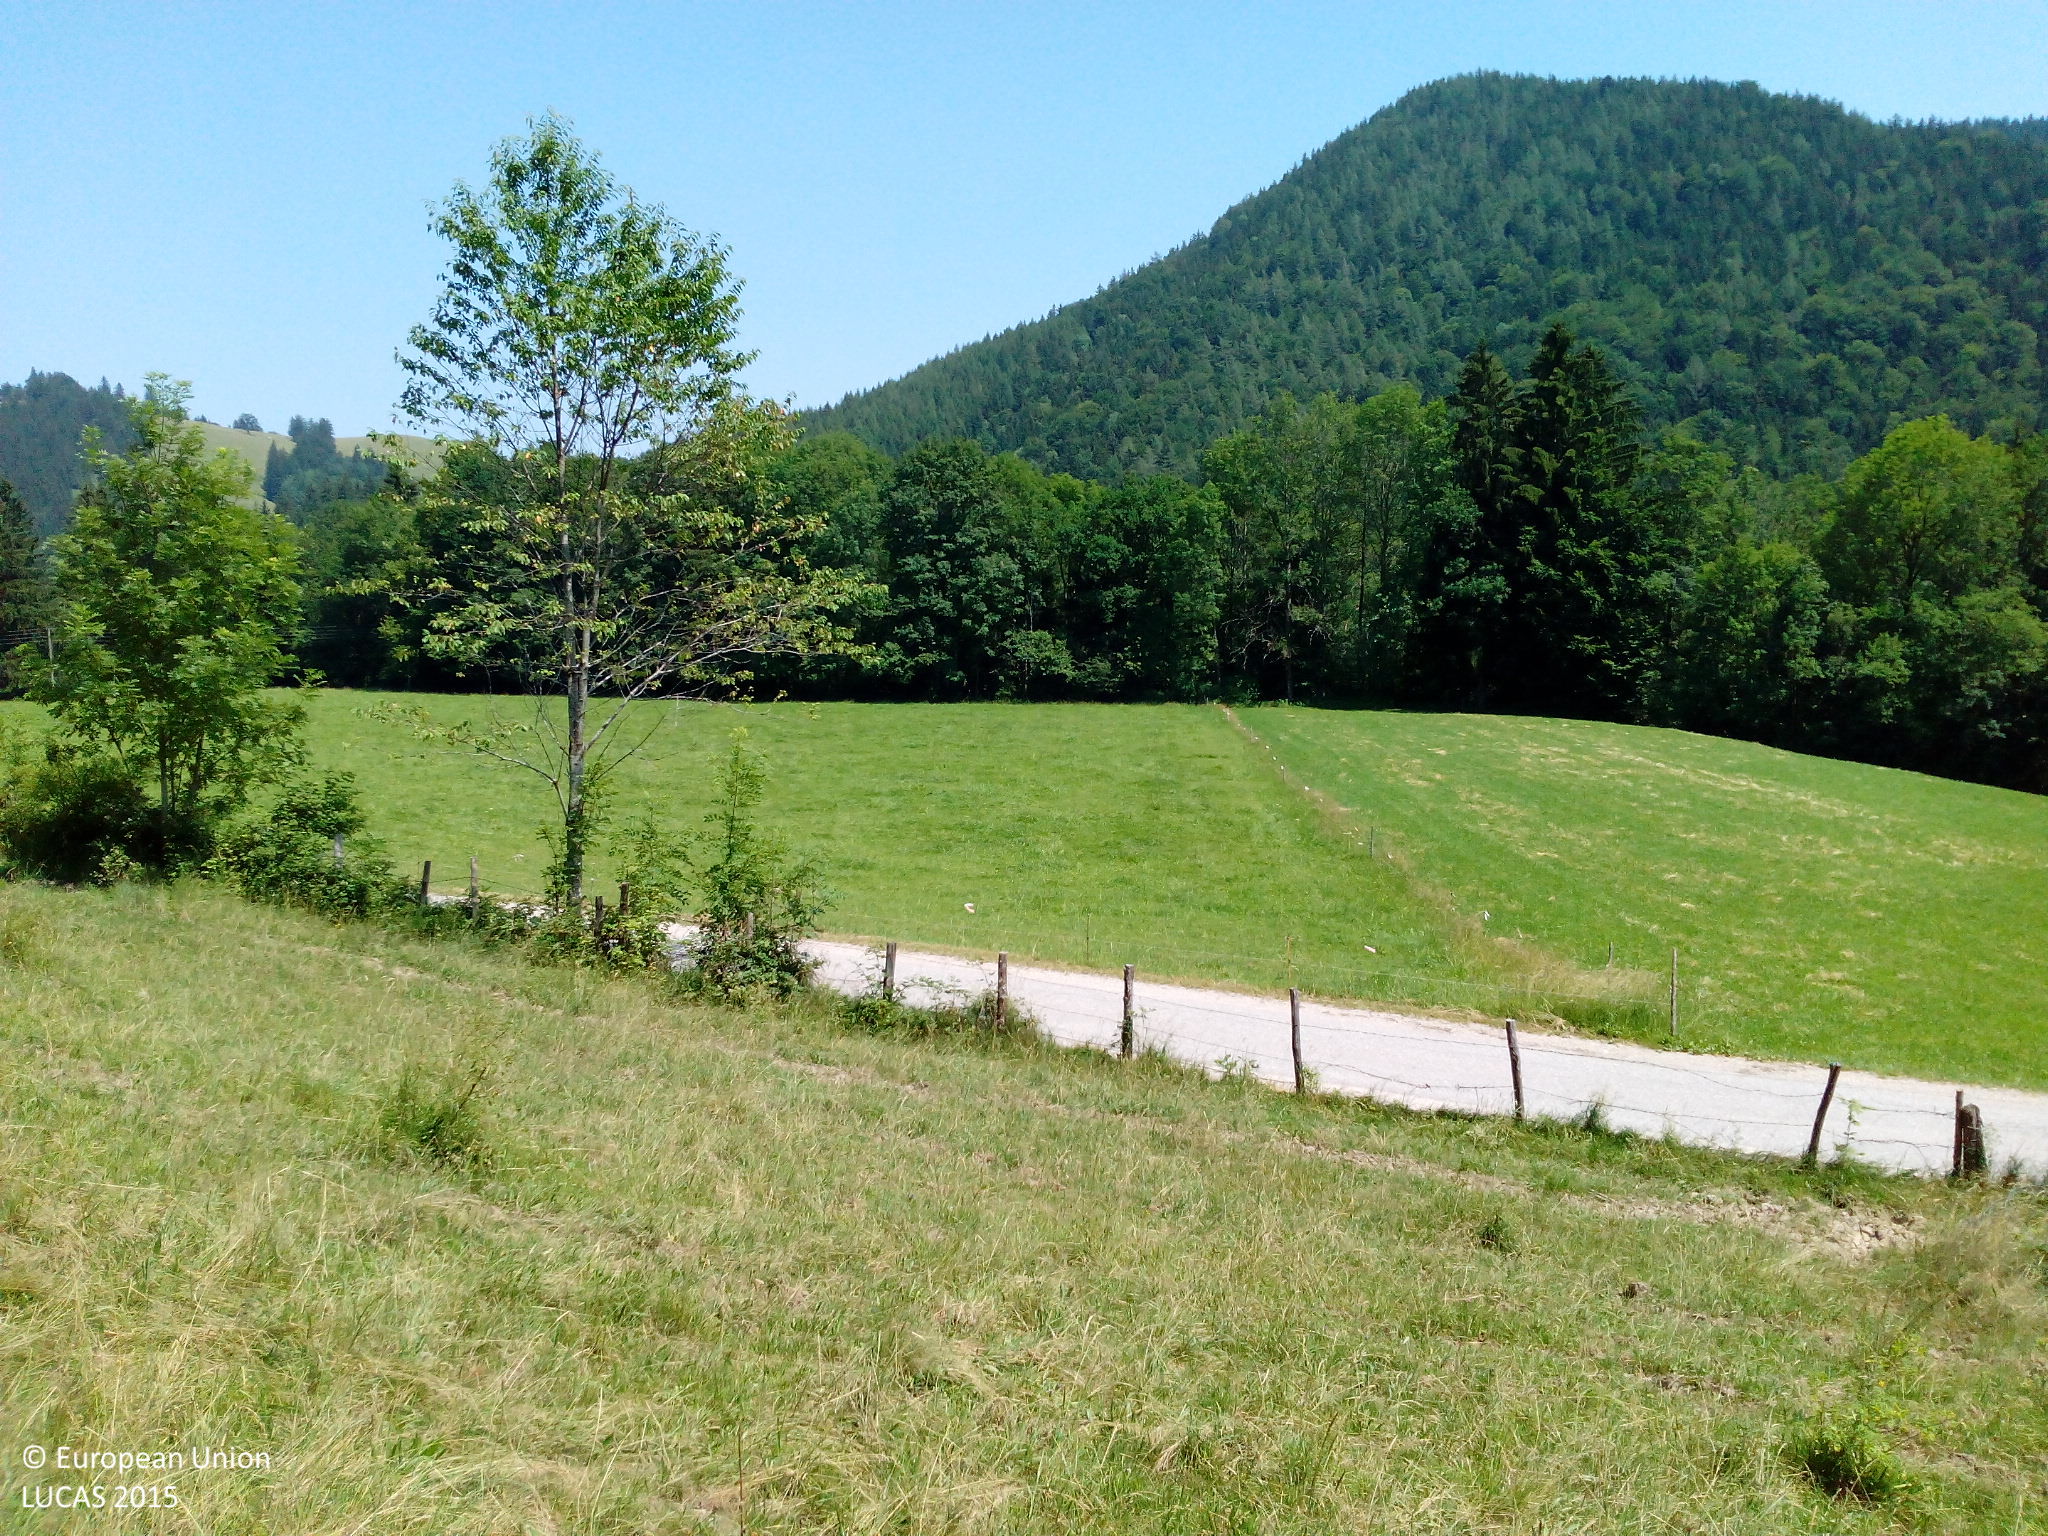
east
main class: Grassland
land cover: Grassland without tree/shrub cover
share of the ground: > 75 %
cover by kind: herbaceous plants 100 %
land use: Agriculture (excluding fallow land and kitchen gardens)
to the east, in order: Grassland without tree/shrub cover; Fences; Paved roads, cycling and walking lanes; Fences; Grassland without tree/shrub cover; Fences; Spruce dominated mixed woodland; Fences; Grassland with sparse tree/shrub cover; Electric lines; Grassland without tree/shrub cover
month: July
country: DE
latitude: 47.7842
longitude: 12.3611
